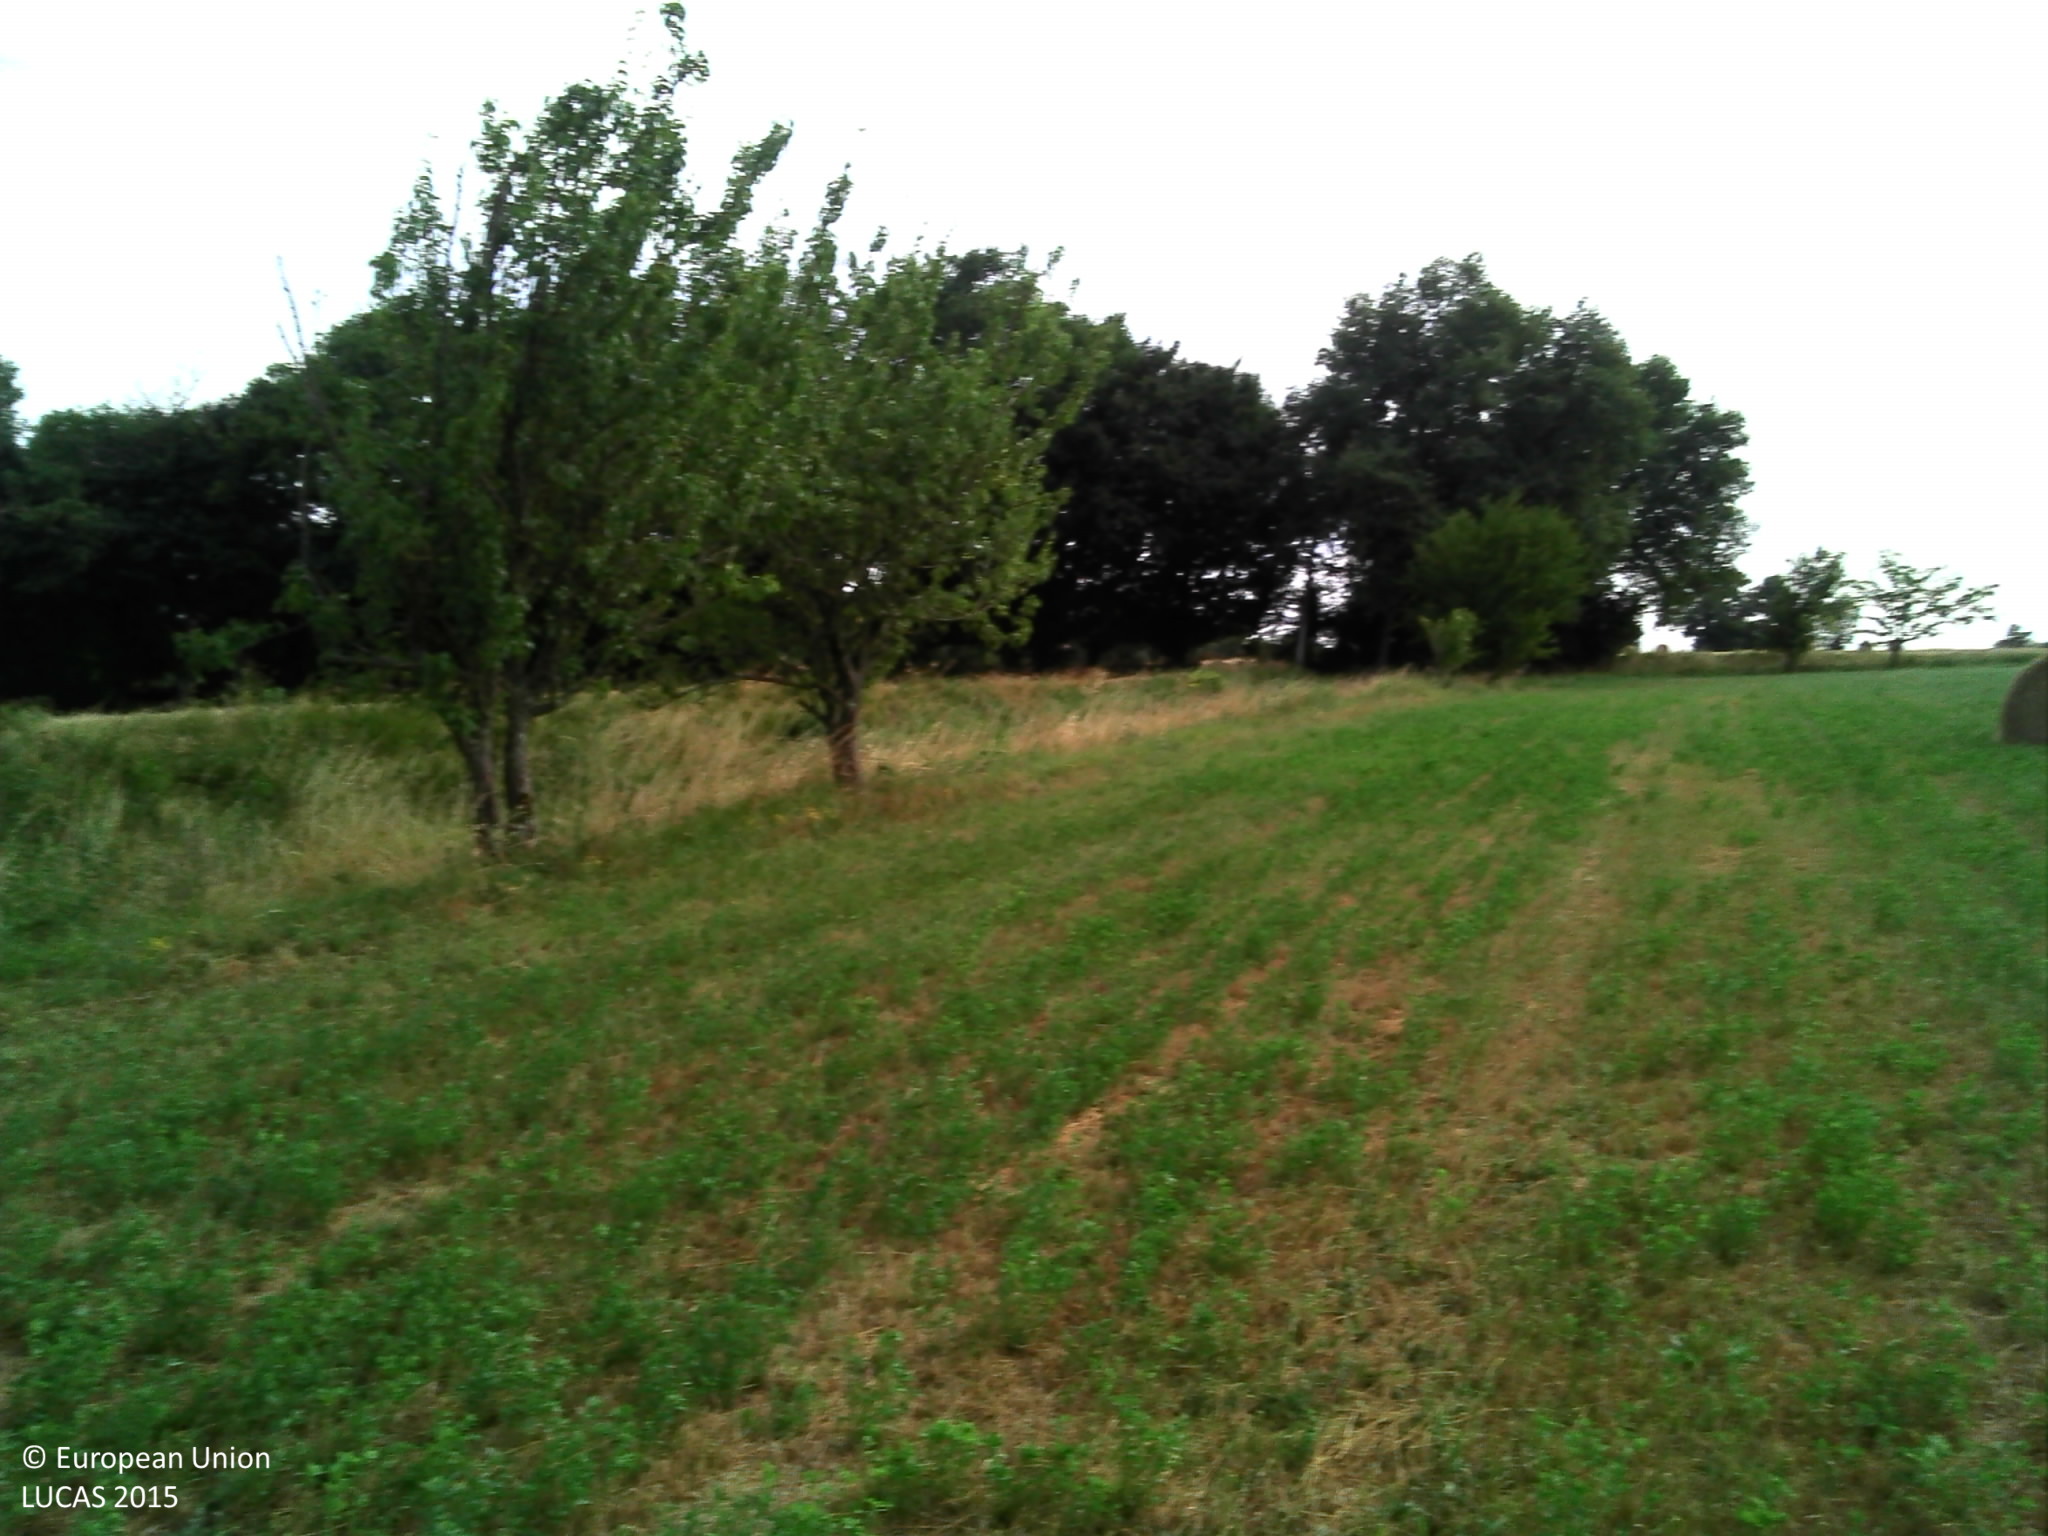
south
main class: Cropland
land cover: Lucerne
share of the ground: > 75 %
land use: Agriculture (excluding fallow land and kitchen gardens)
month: July
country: FR
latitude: 43.6134
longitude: 0.9922
